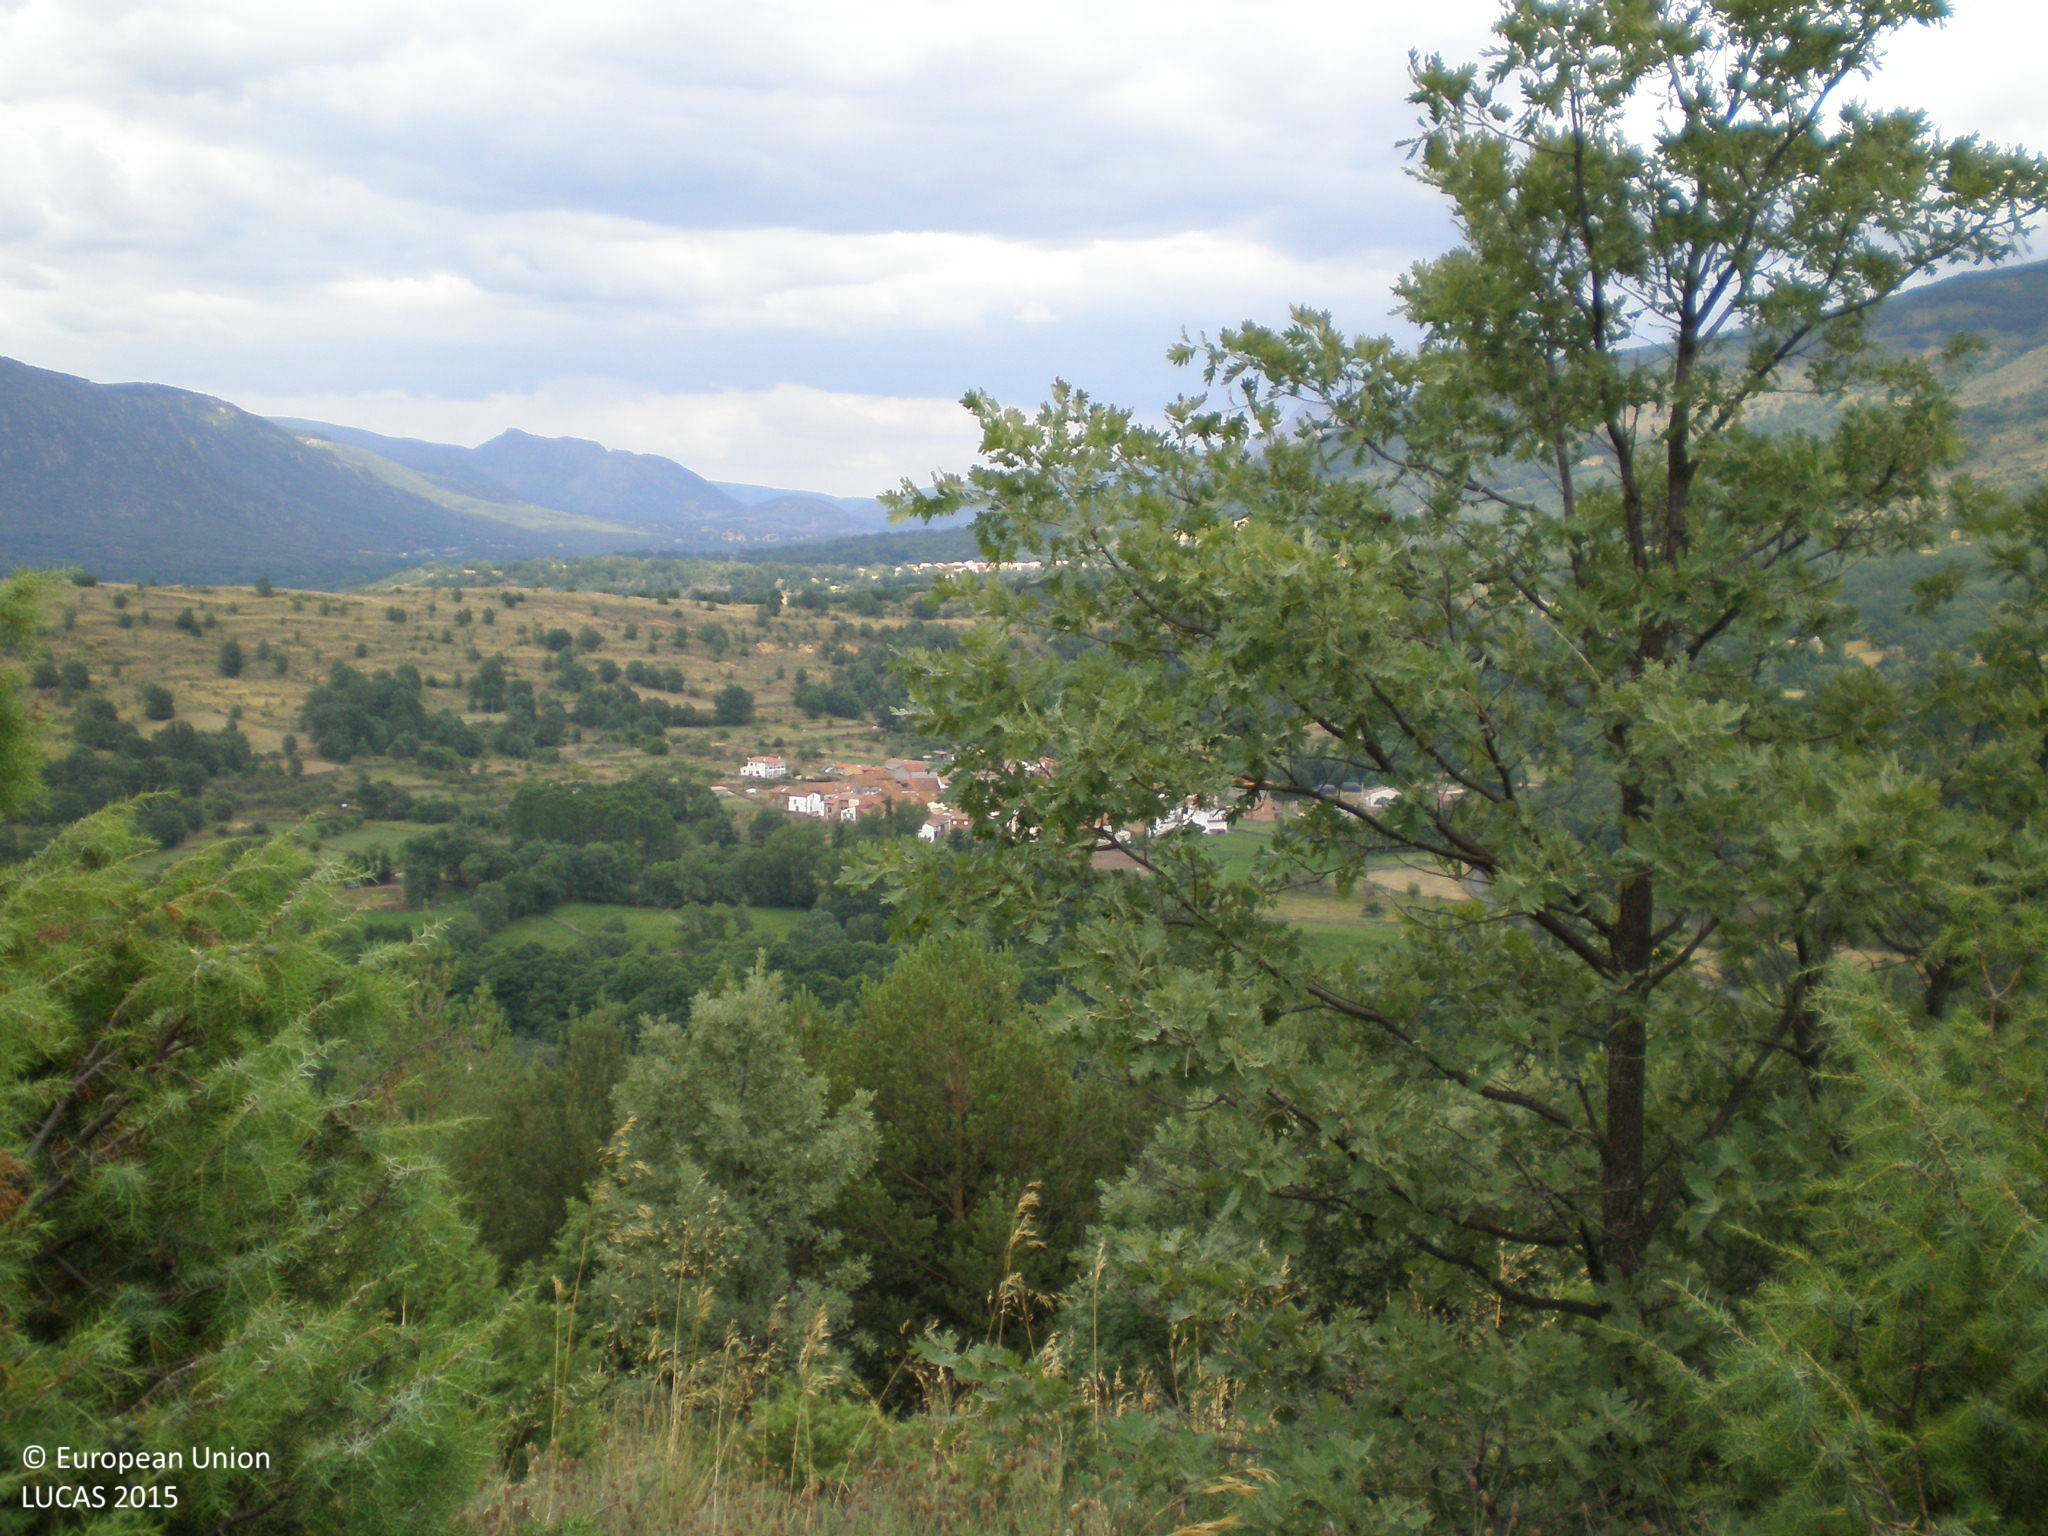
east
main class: Shrubland
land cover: Shrubland without tree cover
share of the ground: > 75 %
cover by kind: shrubs 100 %
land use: Semi-natural and natural areas not in use
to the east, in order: Shrubland without tree cover; Artificial constructions; Broadleaved woodland; Grass margins; Paved roads, cycling and walking lanes; Grass margins; Broadleaved woodland
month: June
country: ES
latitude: 40.3114
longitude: -5.5147
